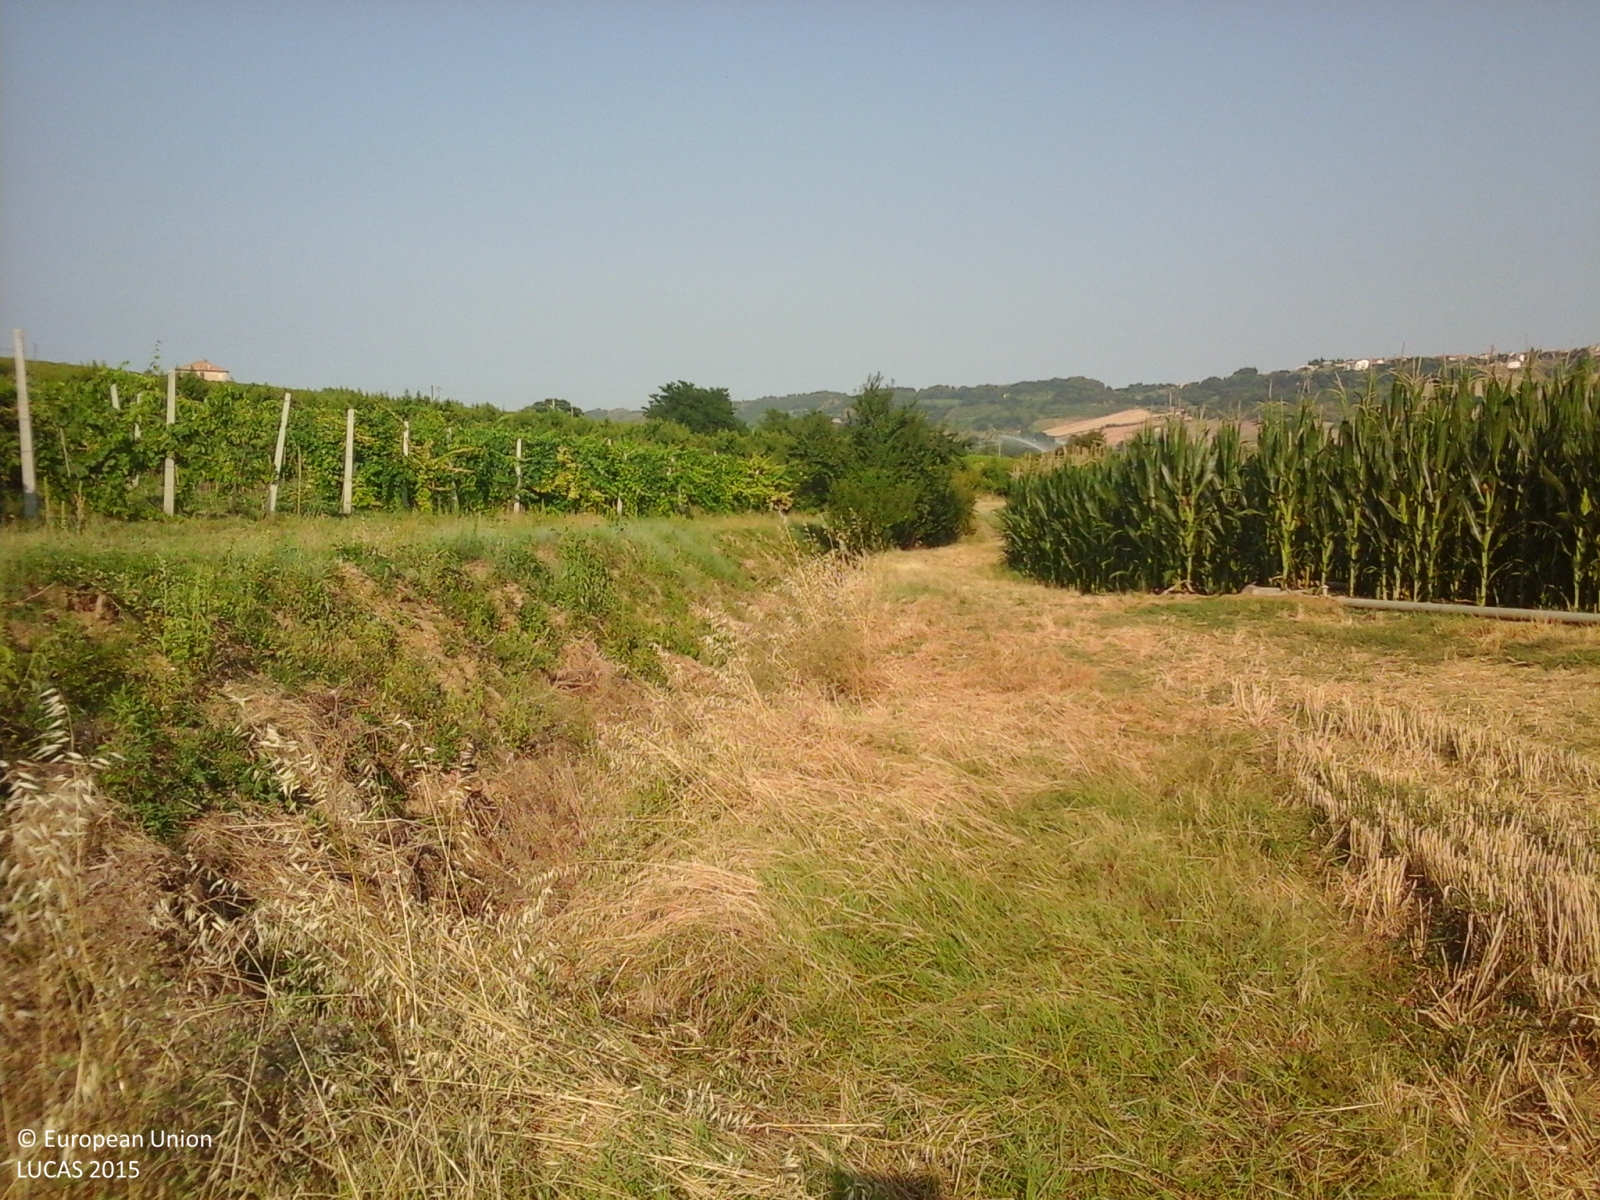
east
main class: Cropland
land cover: Vineyards
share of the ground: 50 - 75 %
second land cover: Grassland without tree/shrub cover
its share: > 75 %
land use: Agriculture (excluding fallow land and kitchen gardens)
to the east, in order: Grass margins; Ditches and canals; Grass margins; Vineyards; Other fruit trees and berries; Electric lines; Other fruit trees and berries; Grass margins; Ditches and canals; Abandoned hedges; Grass margins; Vineyards
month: July
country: IT
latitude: 43.0894
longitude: 13.7860
